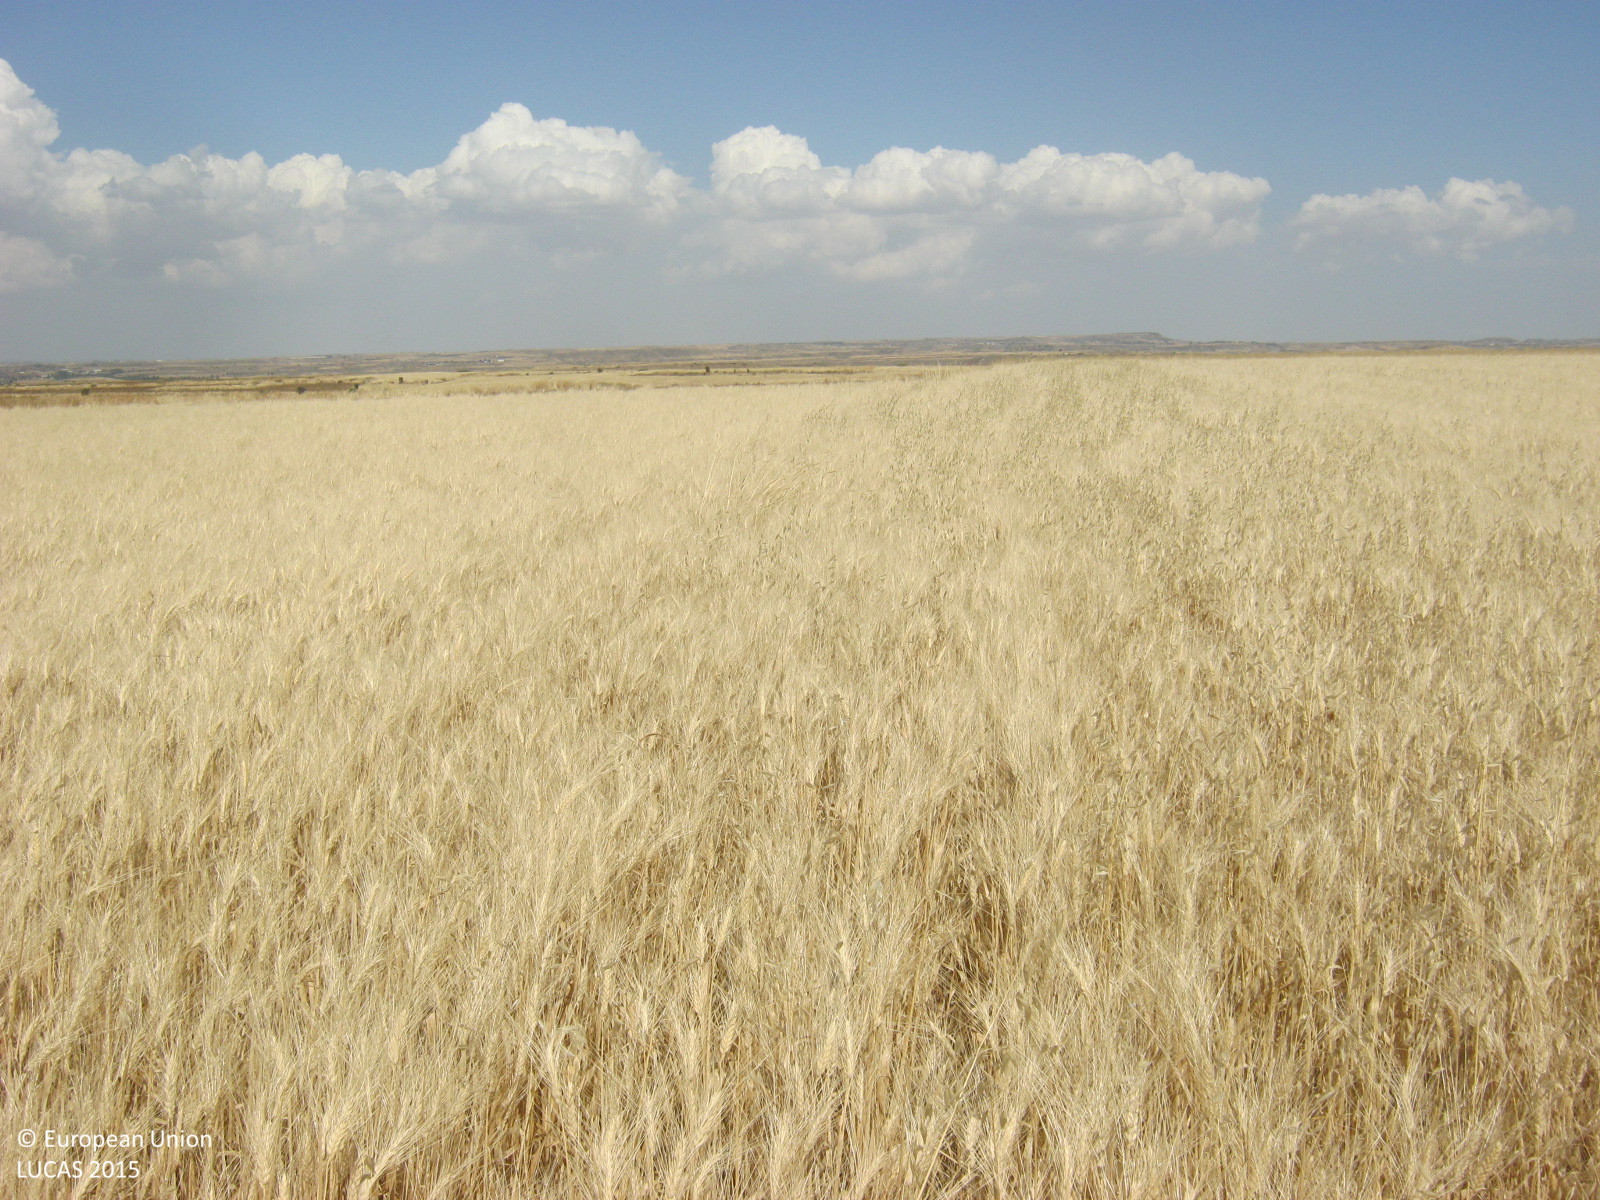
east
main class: Cropland
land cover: Mixed cereals for fodder
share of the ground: > 75 %
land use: Agriculture (excluding fallow land and kitchen gardens)
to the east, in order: Mixed cereals for fodder; Other bare soil; Grassland without tree/shrub cover
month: May
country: CY
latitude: 35.0887
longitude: 33.0940
